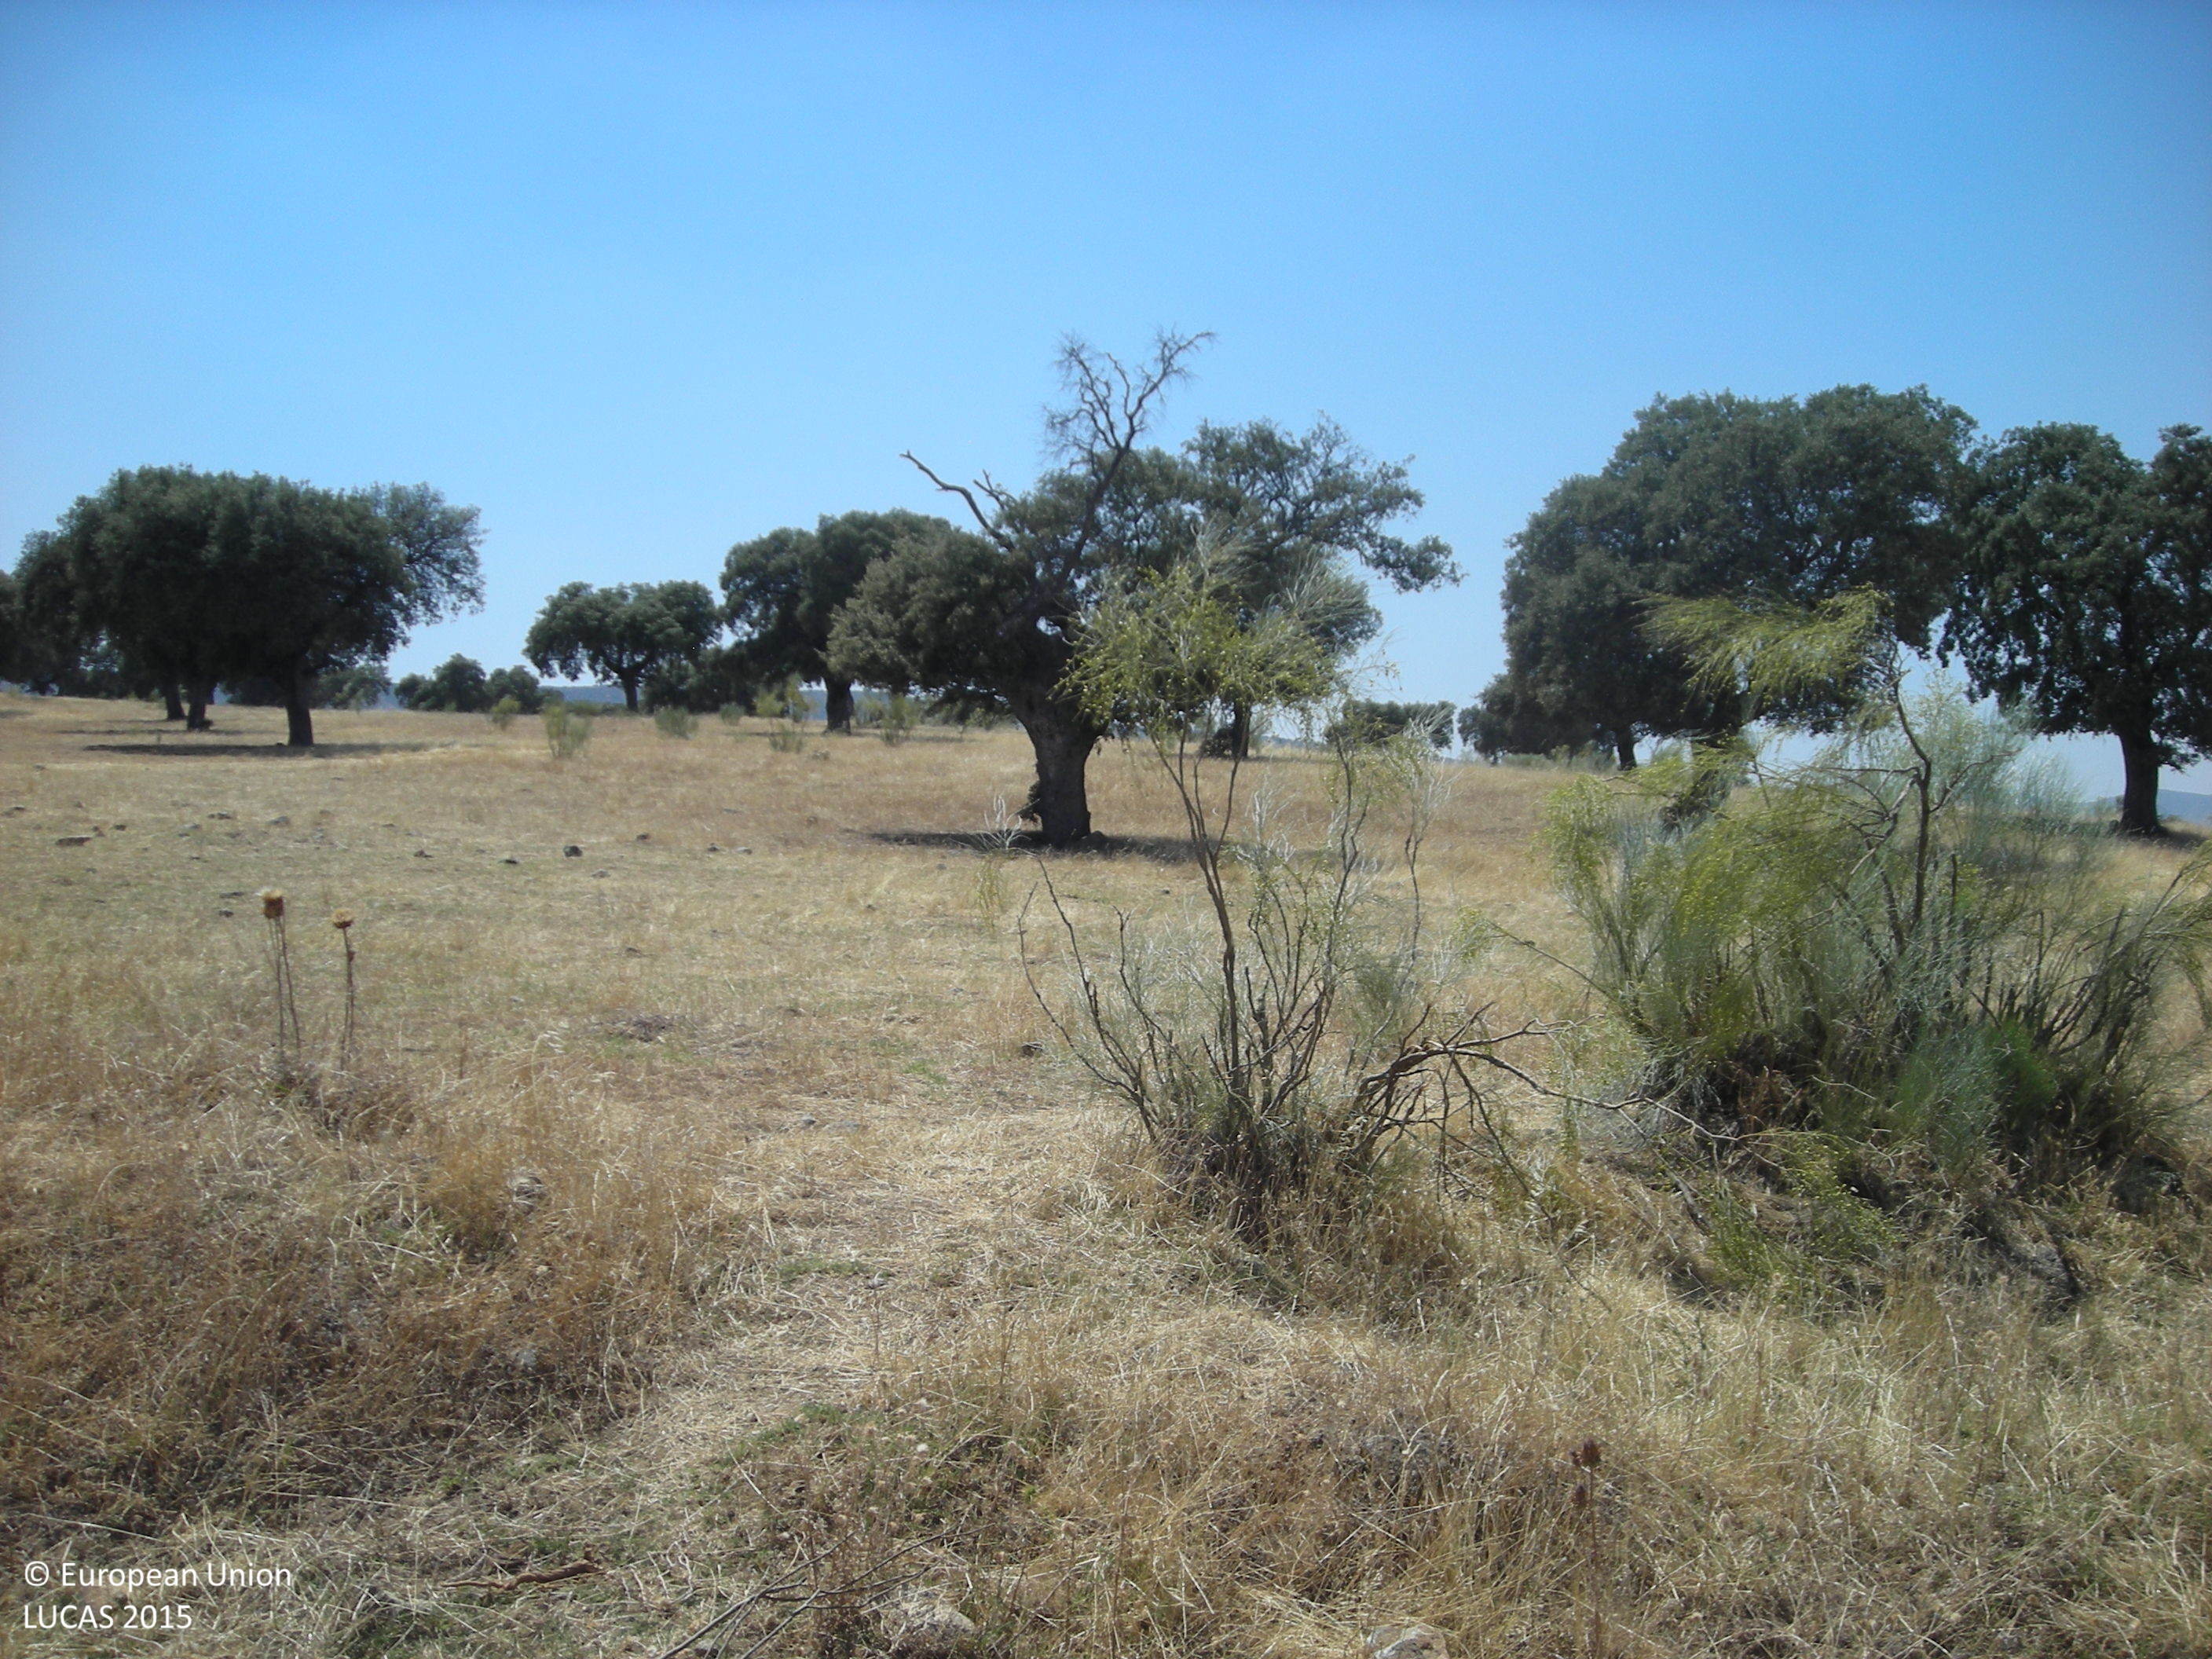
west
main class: Woodland
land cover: Broadleaved woodland
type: broadleaved evergreen forest
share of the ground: 10 - 25 %
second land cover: Grassland without tree/shrub cover
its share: 50 - 75 %
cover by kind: herbaceous plants 60 %, broadleaved forest trees 40 %
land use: Forestry
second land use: Agriculture (excluding fallow land and kitchen gardens)
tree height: > 5 m
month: June
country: ES
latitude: 38.6651
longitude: -5.7998
